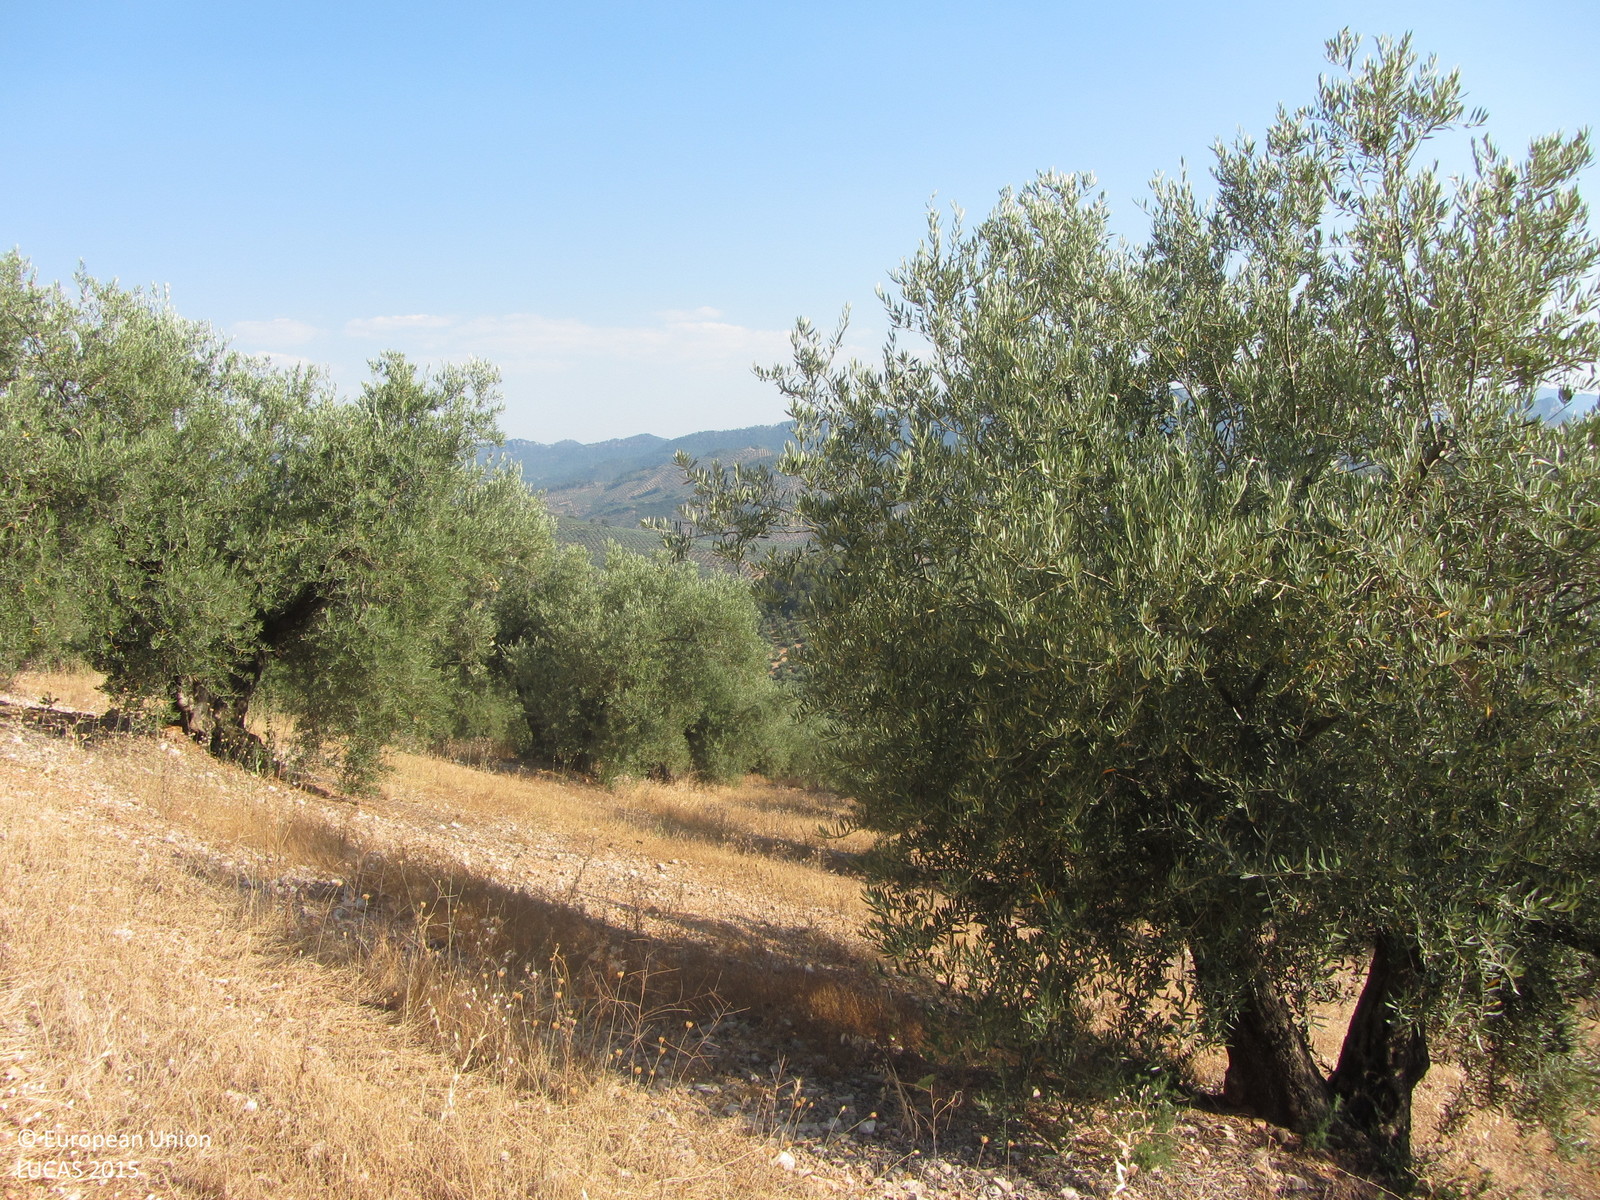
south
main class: Cropland
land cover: Olive groves
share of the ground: 25 - 50 %
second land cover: Spontaneously vegetated surfaces
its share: 10 - 25 %
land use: Agriculture (excluding fallow land and kitchen gardens)
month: June
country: ES
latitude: 38.2850
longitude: -2.8376
